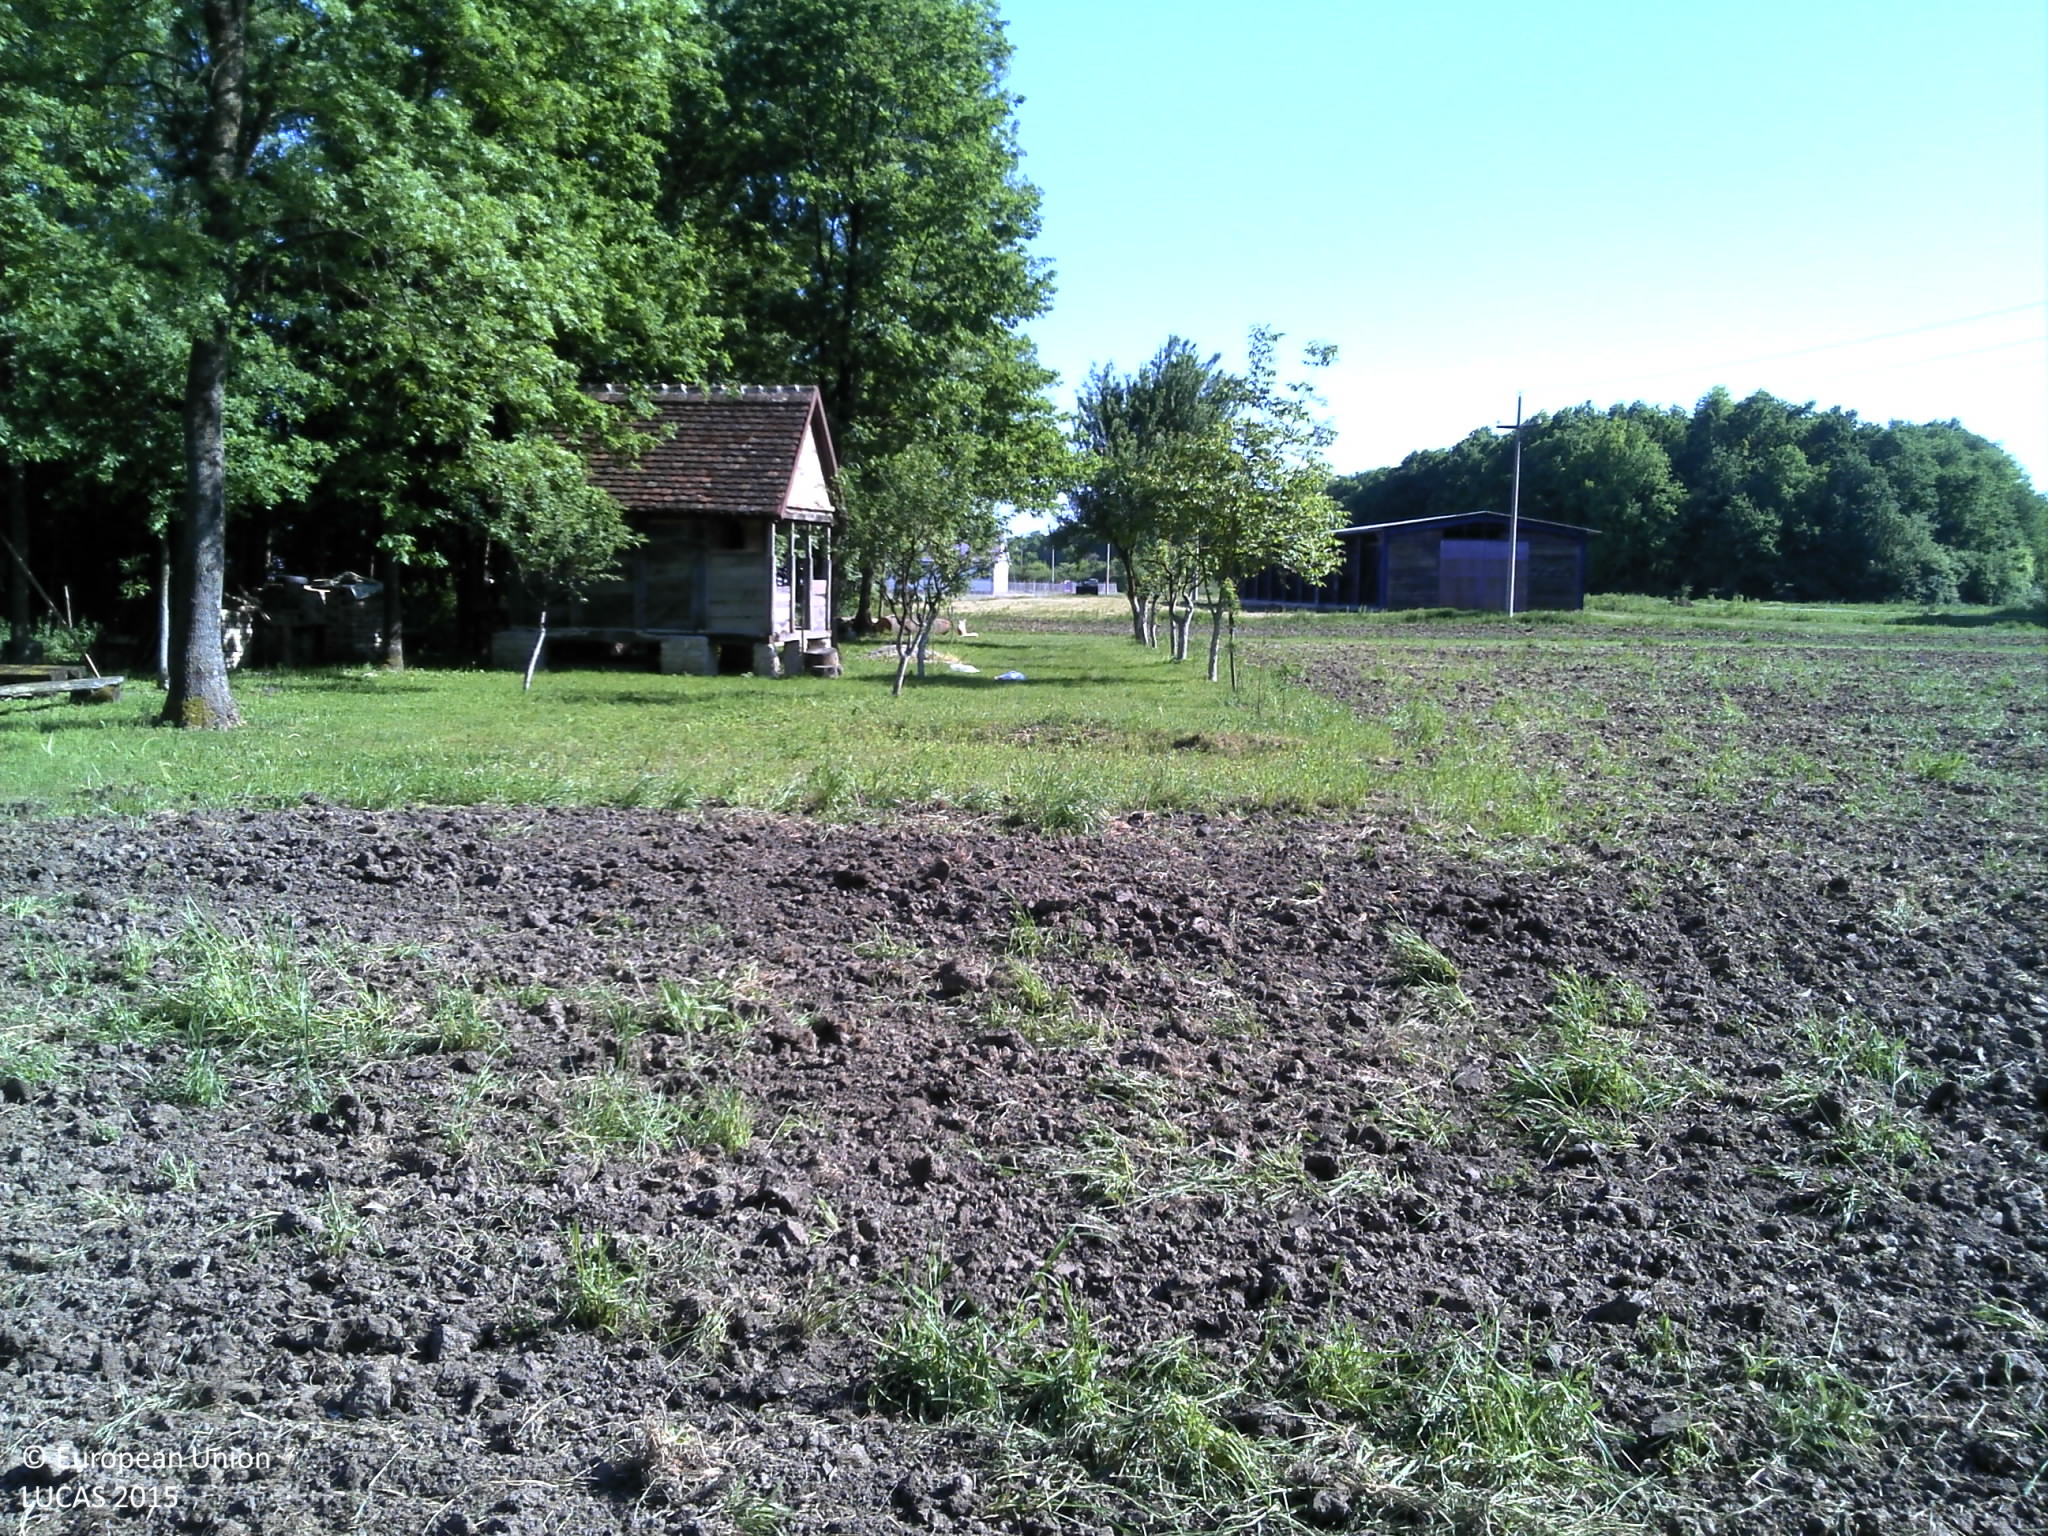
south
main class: Grassland
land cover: Spontaneously vegetated surfaces
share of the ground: < 10 %
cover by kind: unconsolidated bare surface 90 %, herbaceous plants 10 %
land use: Fallow land
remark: Harvested field
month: May
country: HR
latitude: 45.1522
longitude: 18.1563
